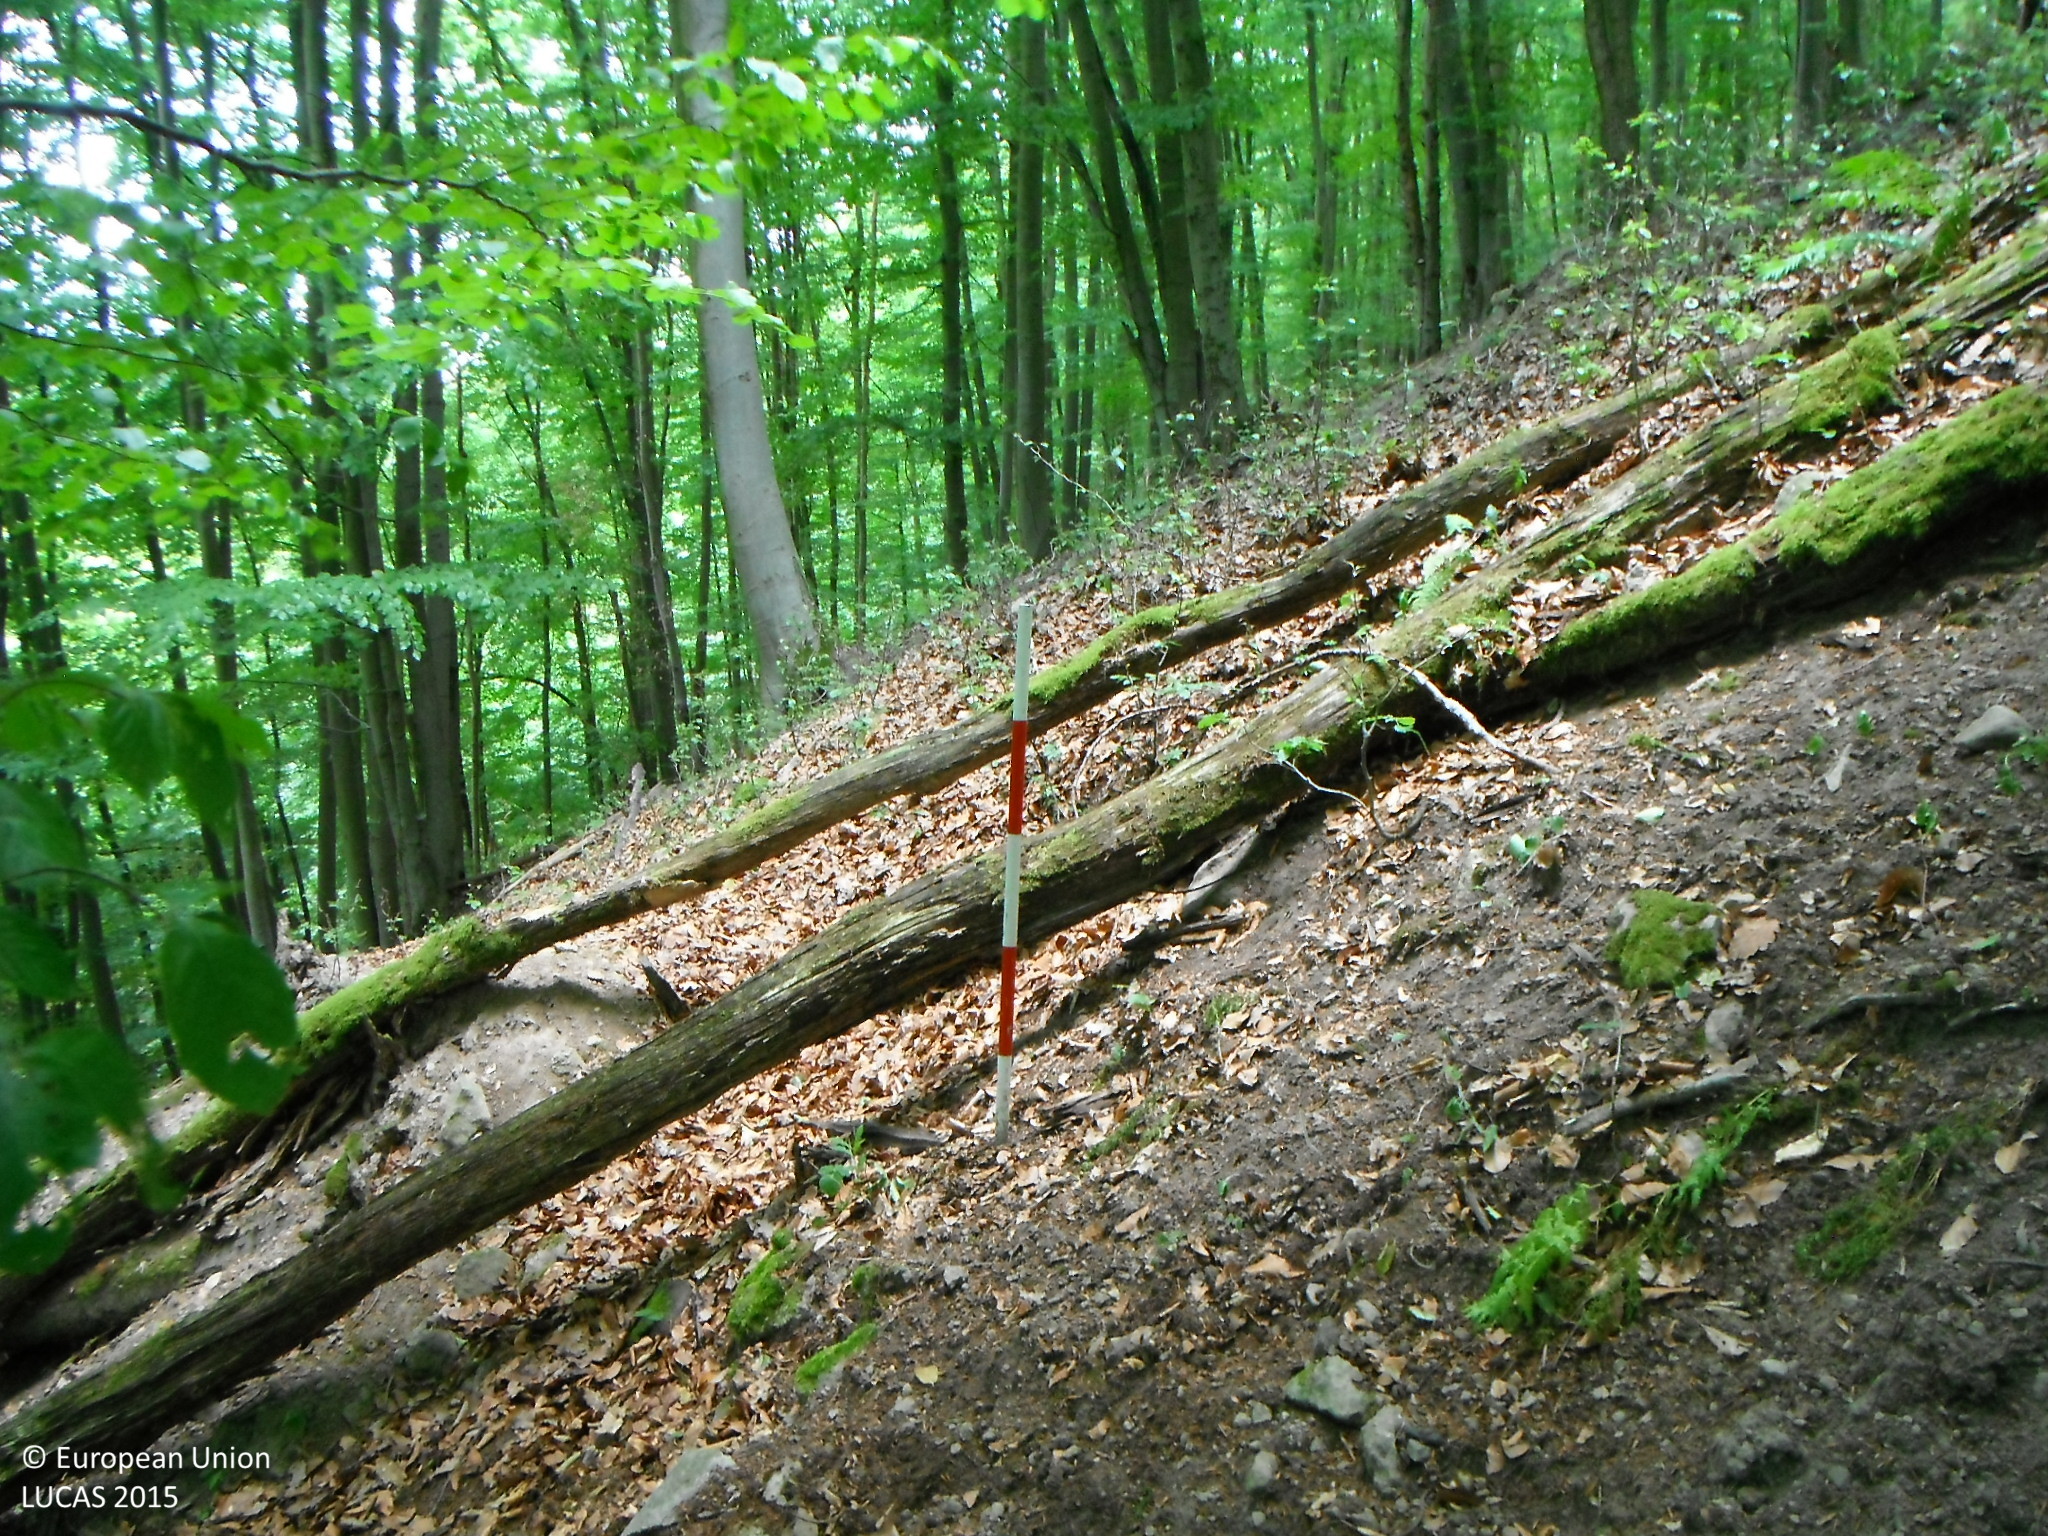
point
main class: Woodland
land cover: Broadleaved woodland
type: beech forest
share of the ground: > 75 %
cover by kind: broadleaved forest trees 100 %
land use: Forestry
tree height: > 5 m
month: July
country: SK
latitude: 48.2149
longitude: 19.0237
